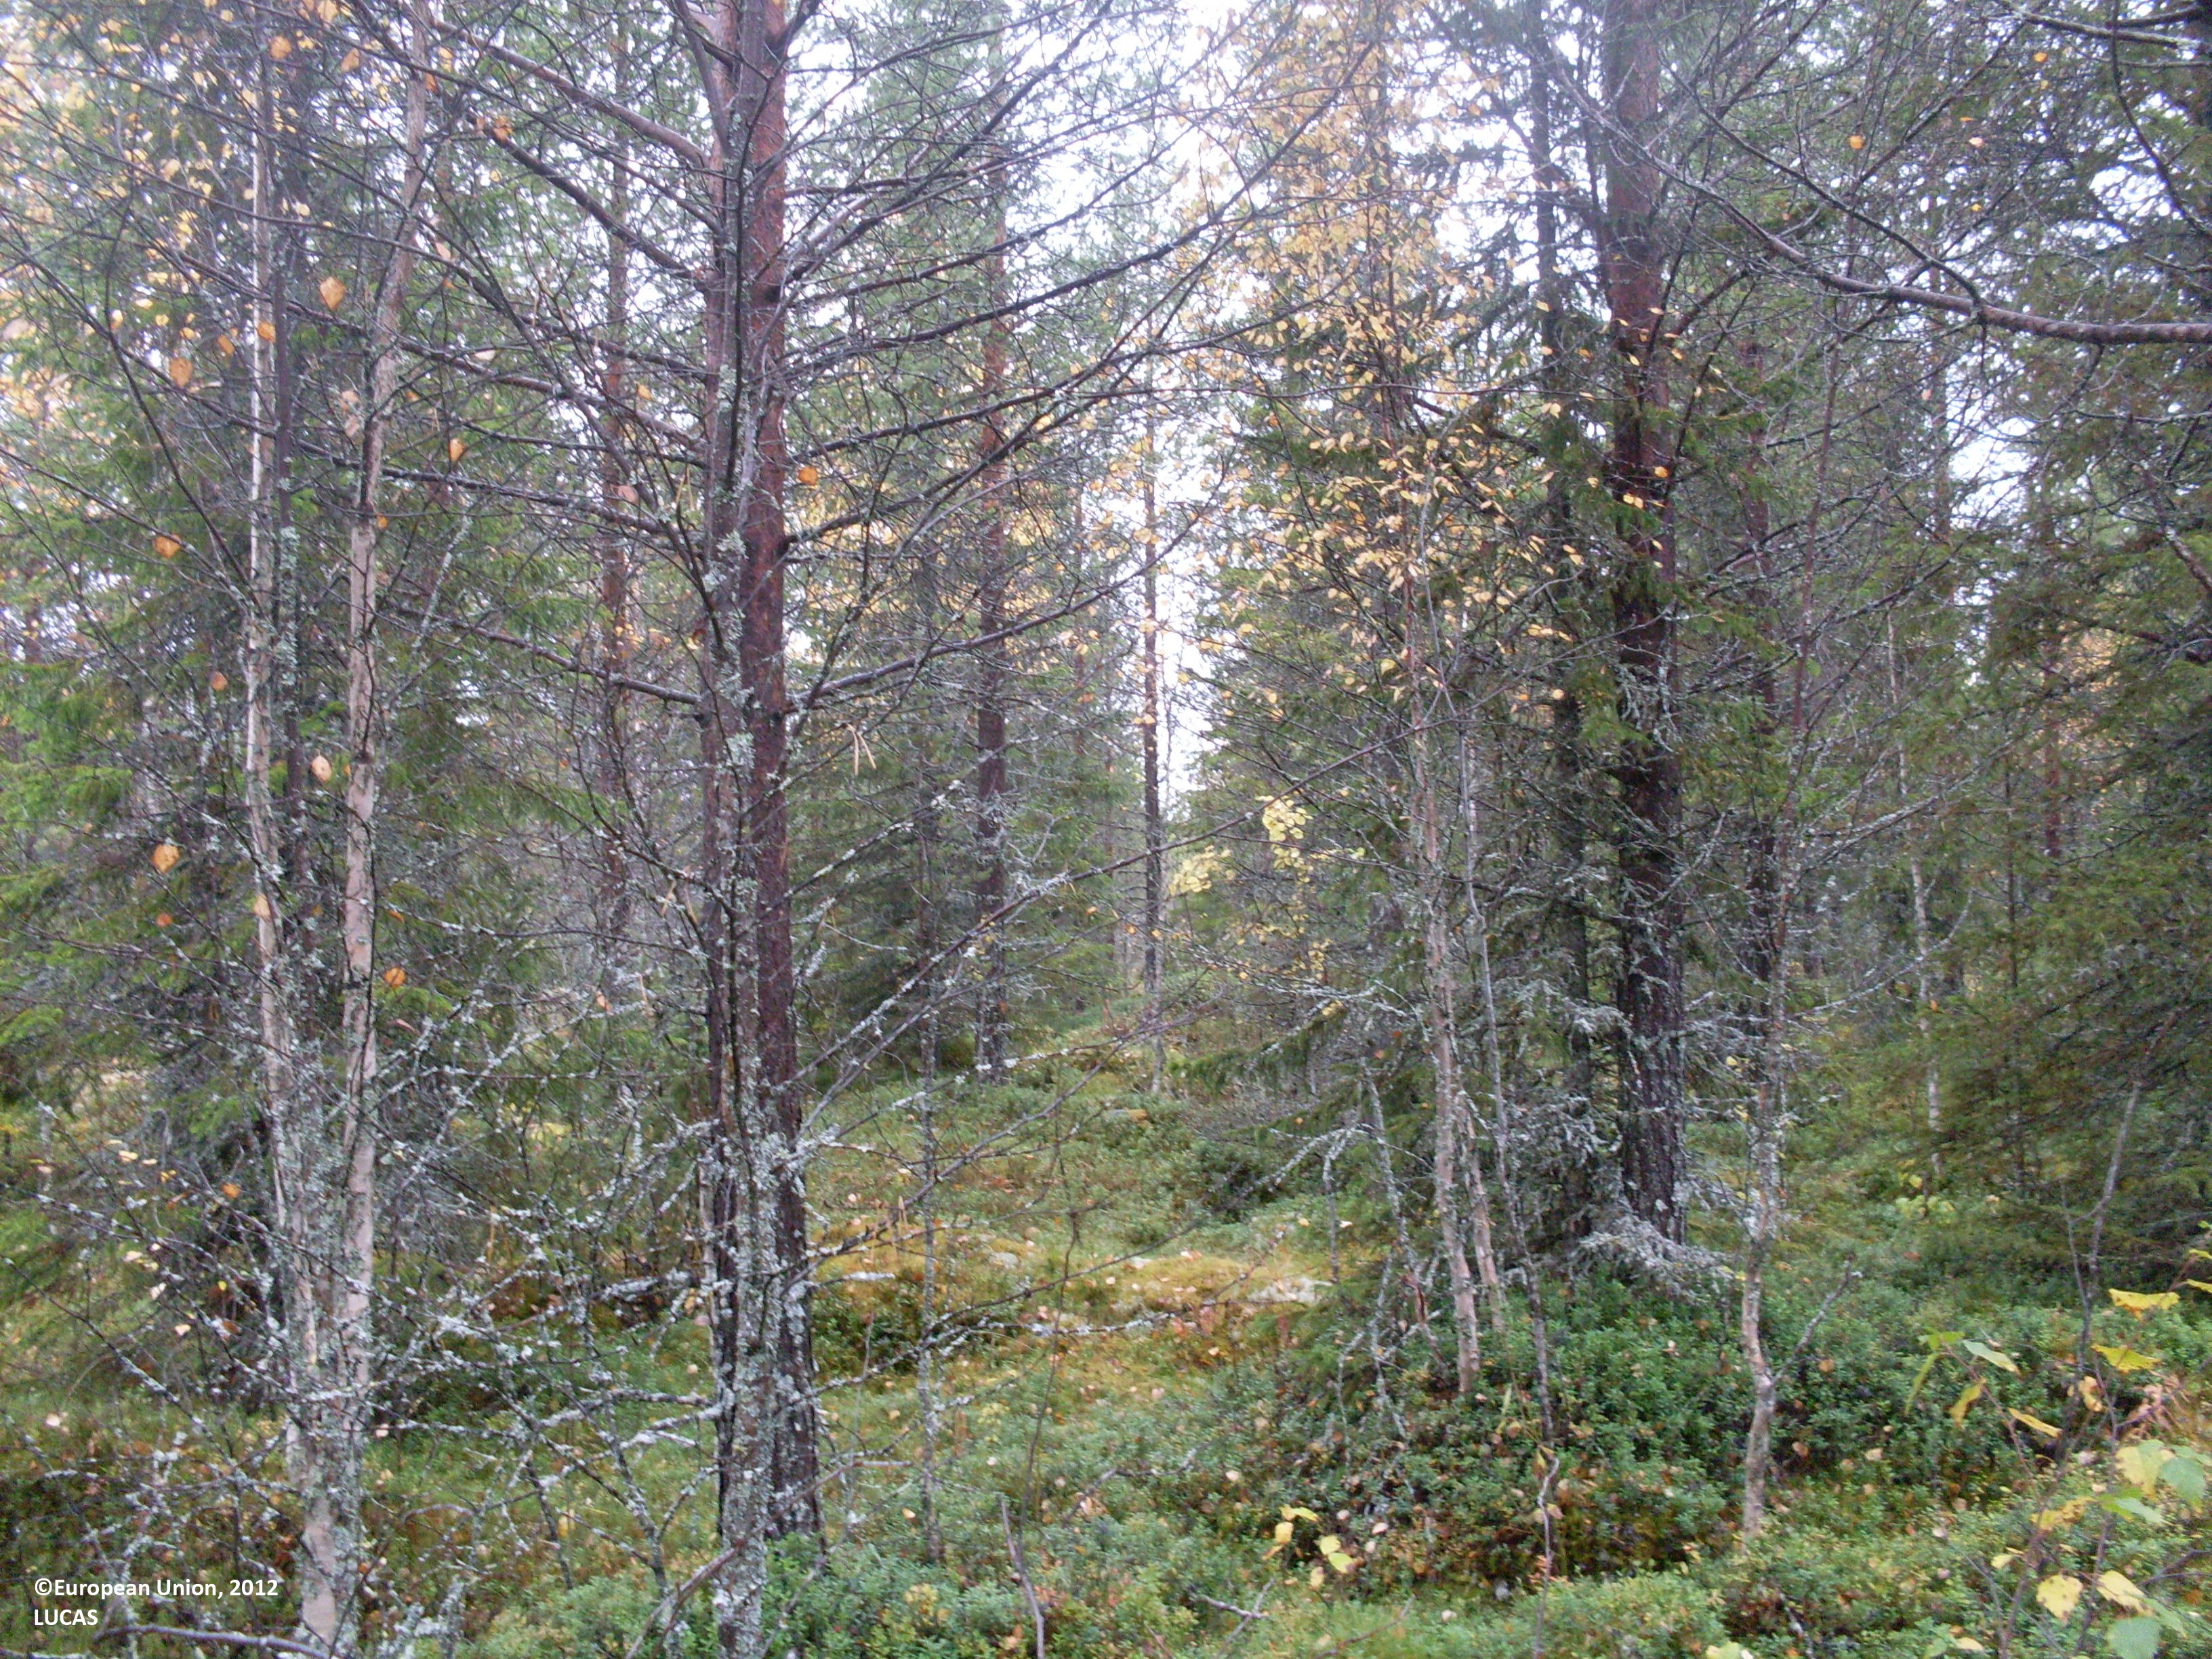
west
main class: Woodland
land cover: Spruce dominated mixed woodland
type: boreal forest
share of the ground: 50 - 75 %
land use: Forestry
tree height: > 5 m
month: September
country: FI
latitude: 64.4348
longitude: 28.6458
